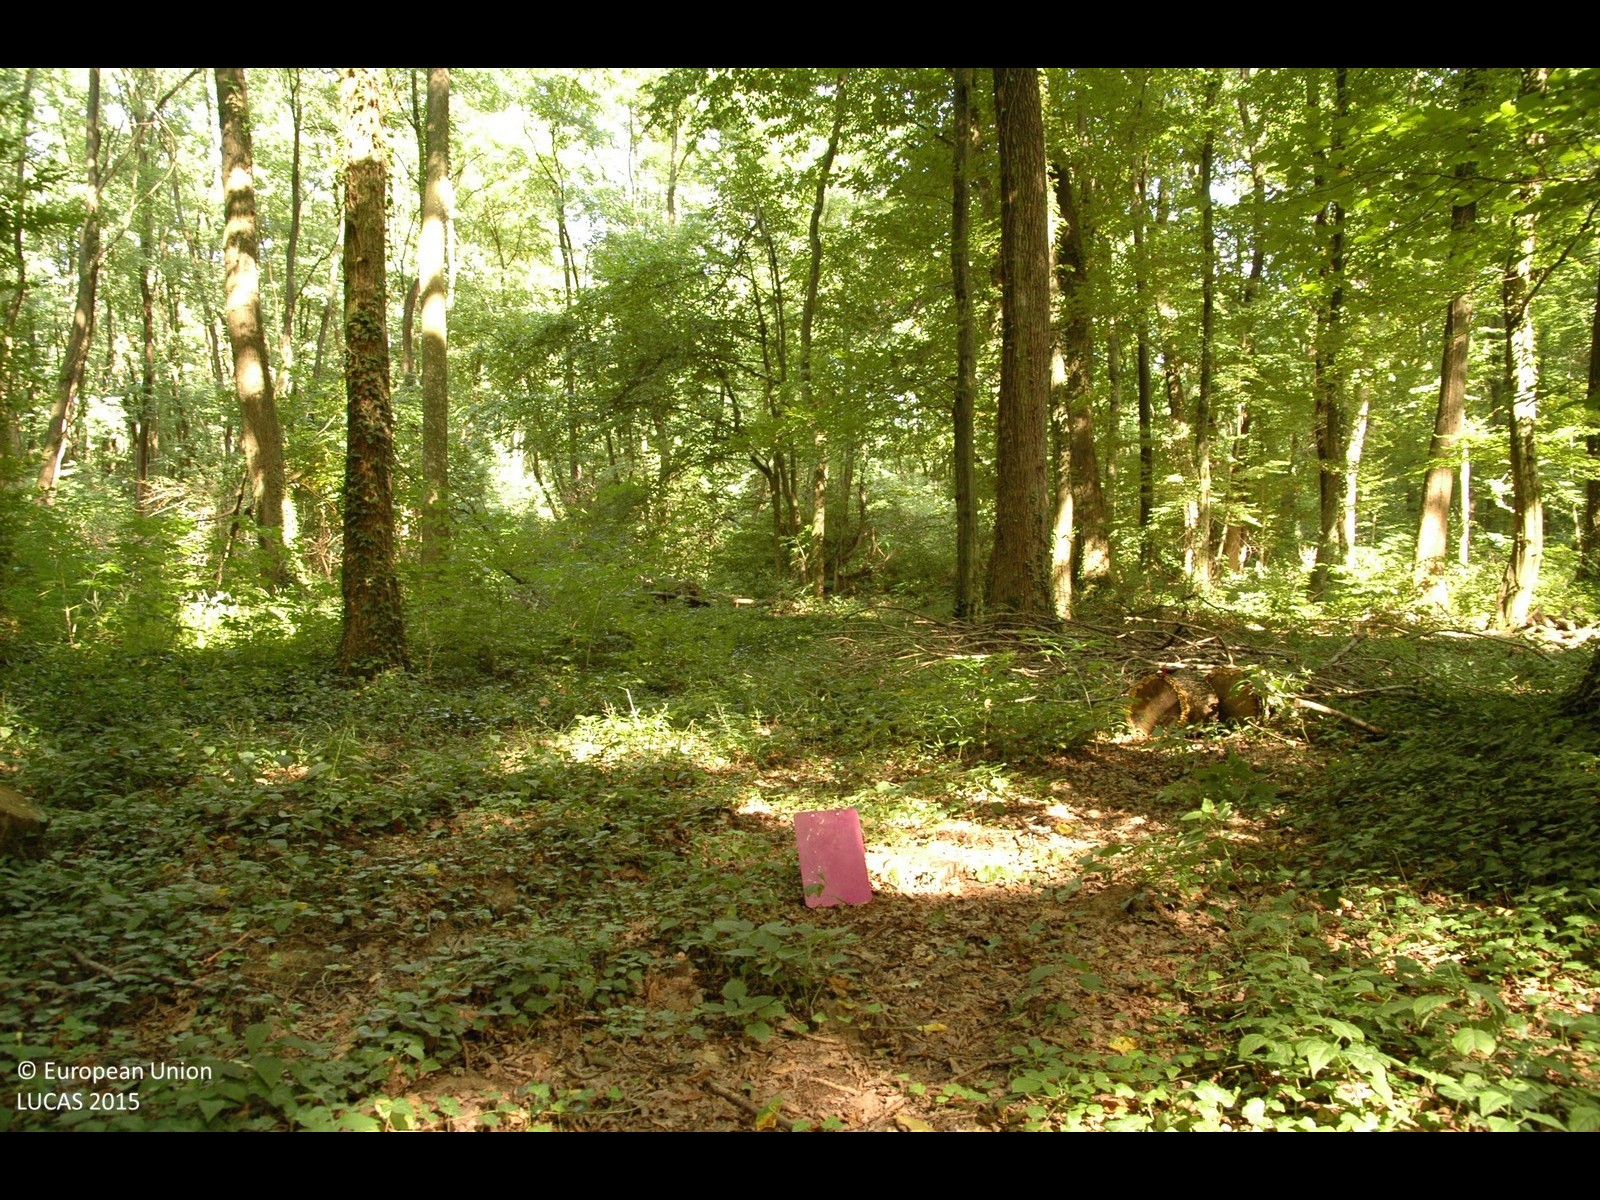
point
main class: Woodland
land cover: Broadleaved woodland
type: mesophytic deciduous forest
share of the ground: > 75 %
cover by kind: broadleaved forest trees 100 %
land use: Forestry
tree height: > 5 m
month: August
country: HR
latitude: 46.1479
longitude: 16.8762
